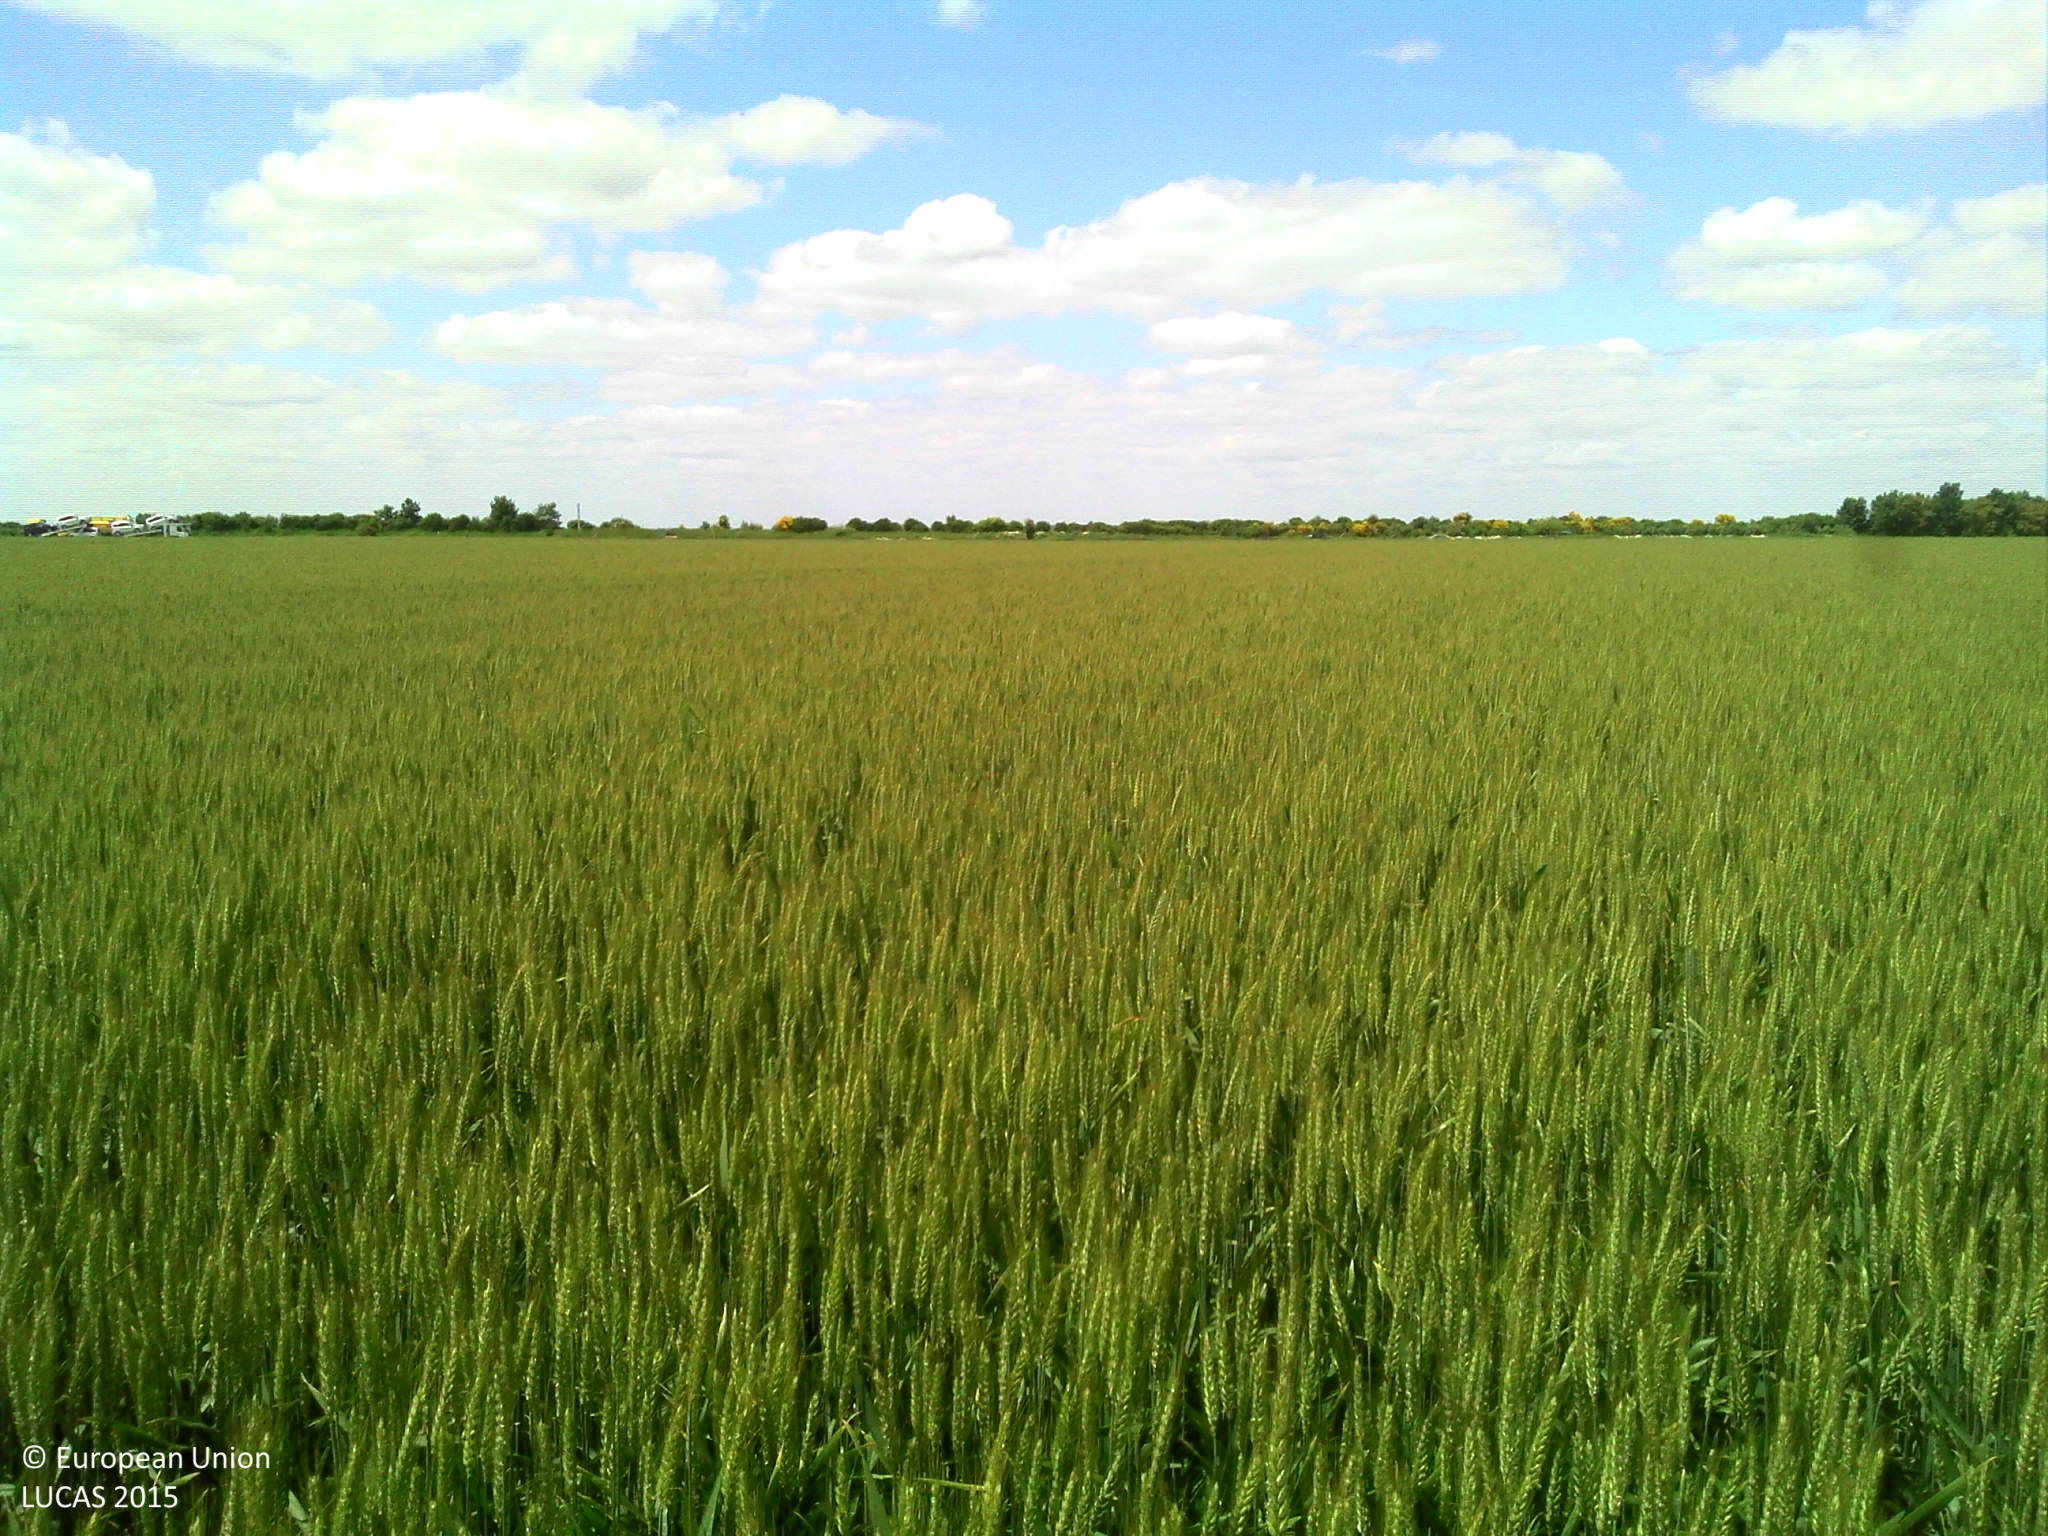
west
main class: Cropland
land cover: Common wheat
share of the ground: > 75 %
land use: Agriculture (excluding fallow land and kitchen gardens)
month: June
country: FR
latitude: 48.3950
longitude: 1.8961
